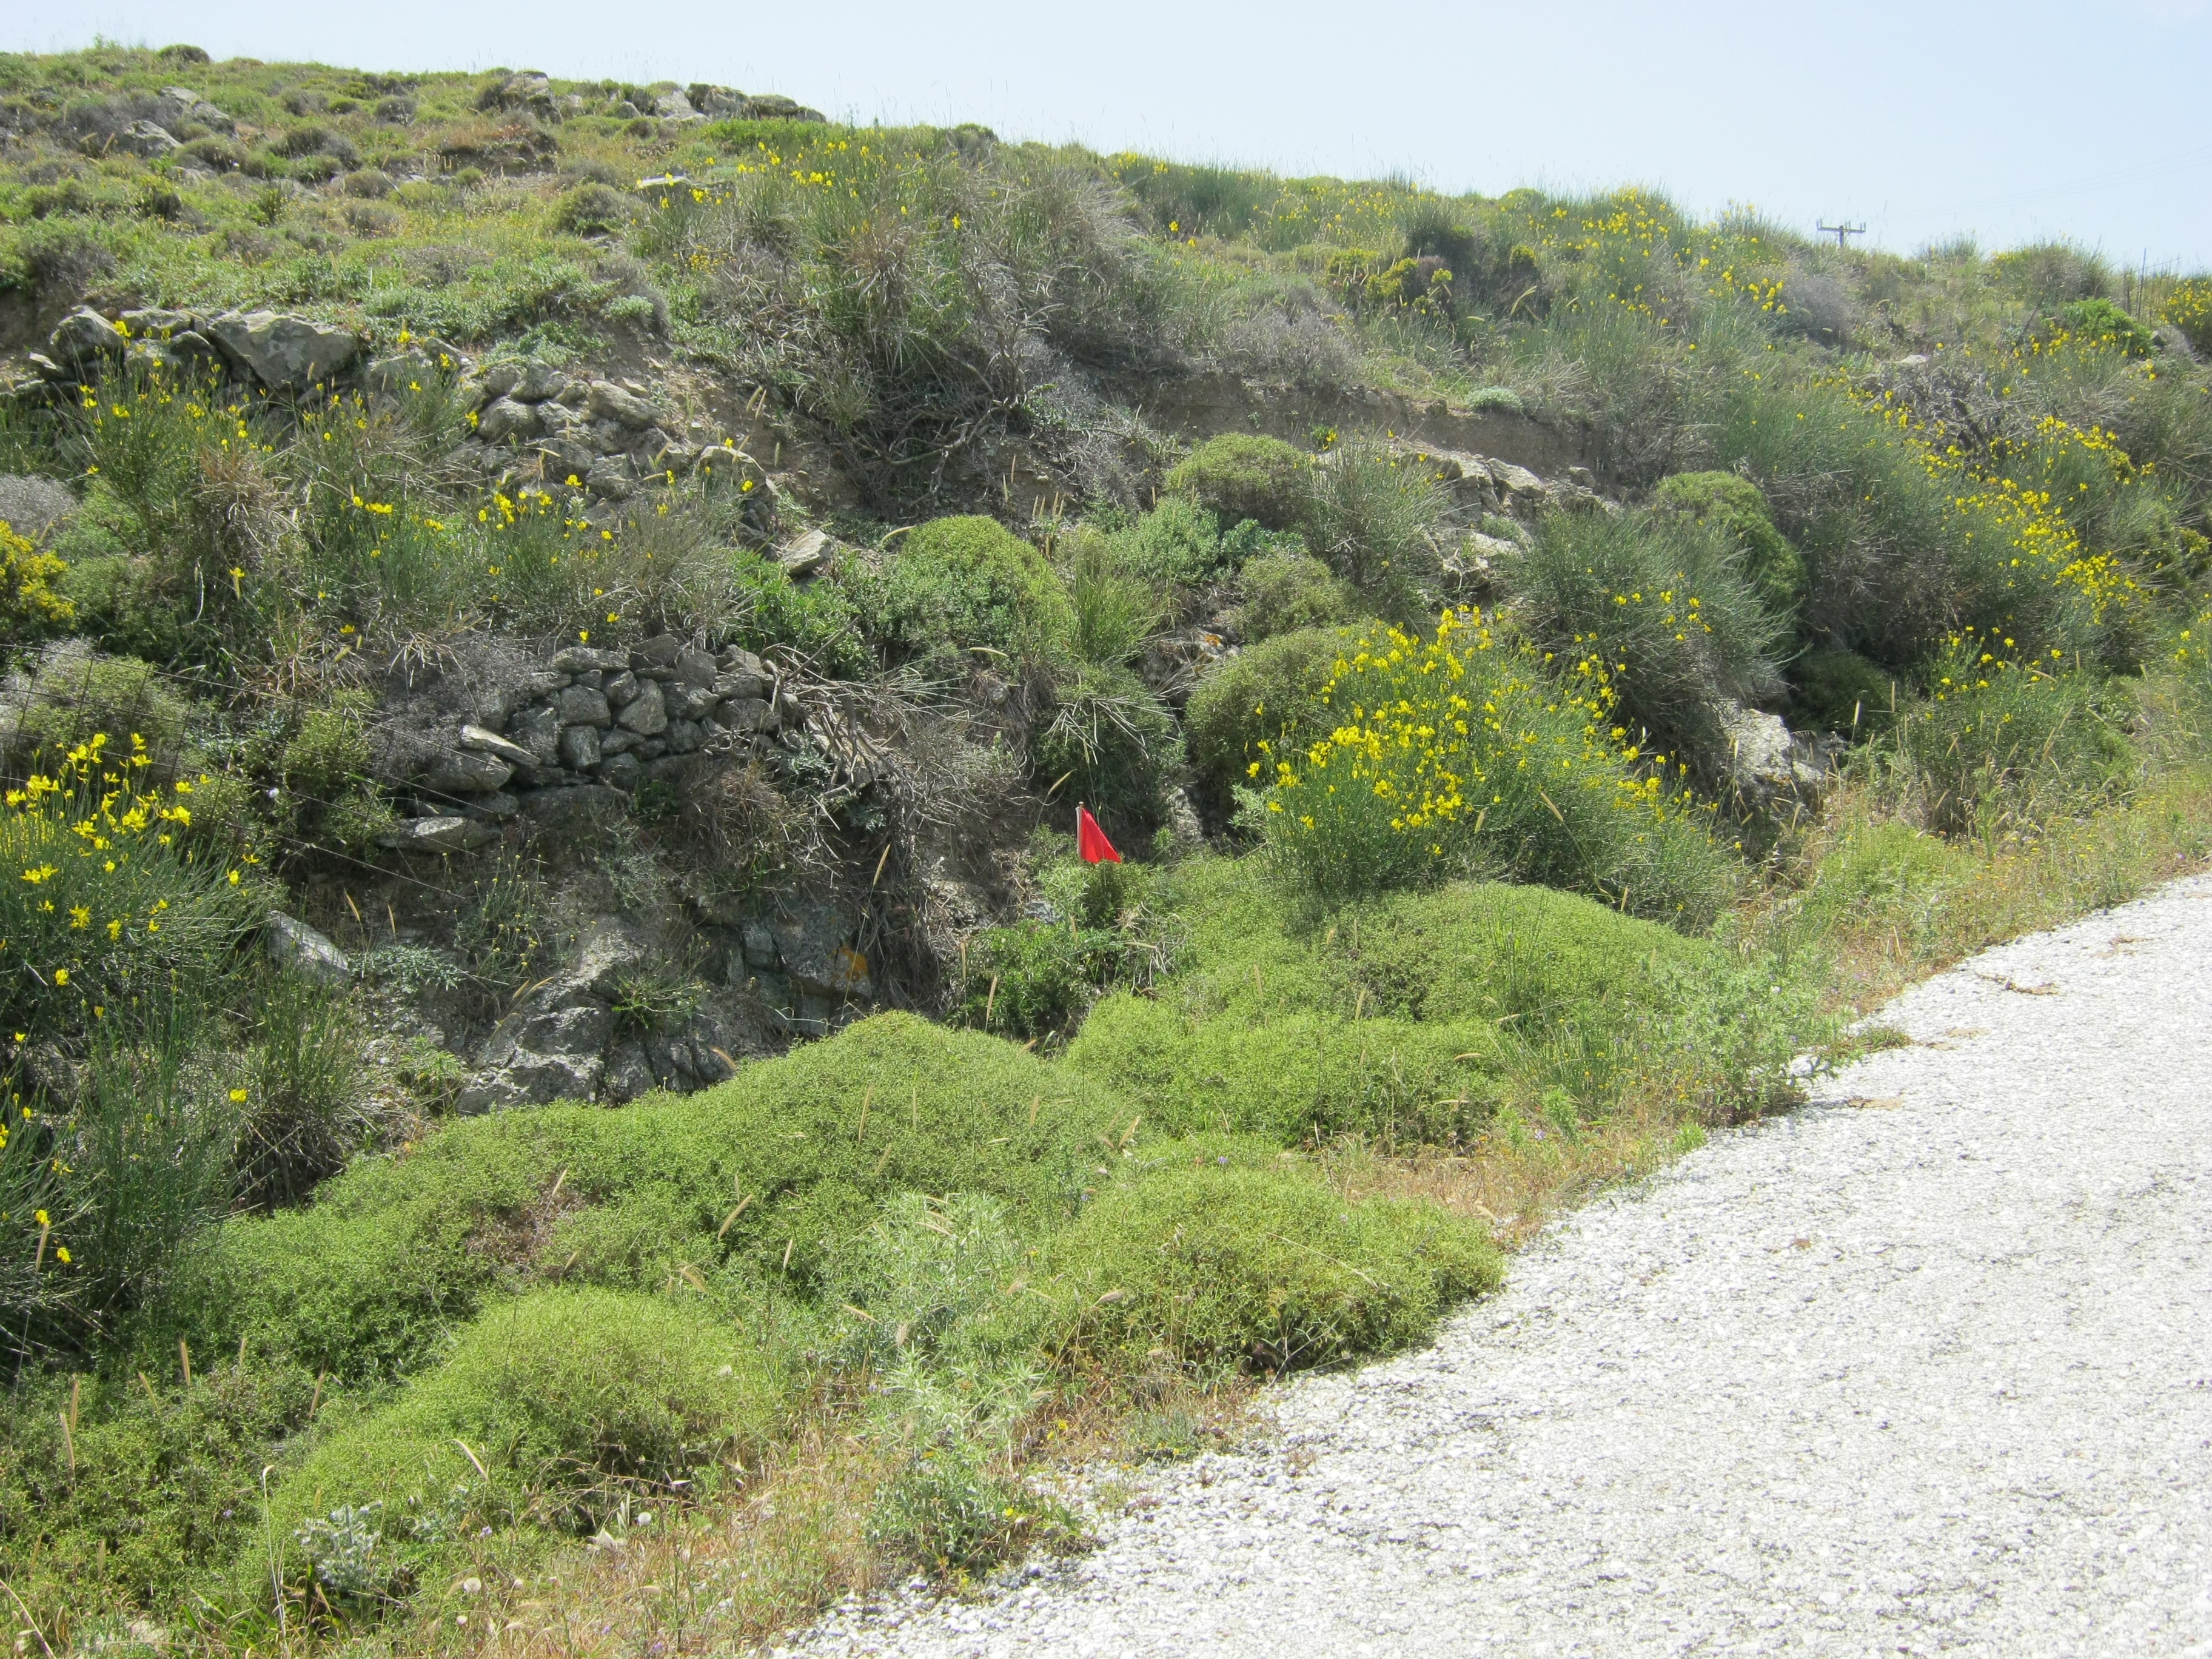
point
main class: Shrubland
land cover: Shrubland without tree cover
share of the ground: > 75 %
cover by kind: shrubs 100 %
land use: Semi-natural and natural areas not in use
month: May
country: GR
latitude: 37.6282
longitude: 25.1648
